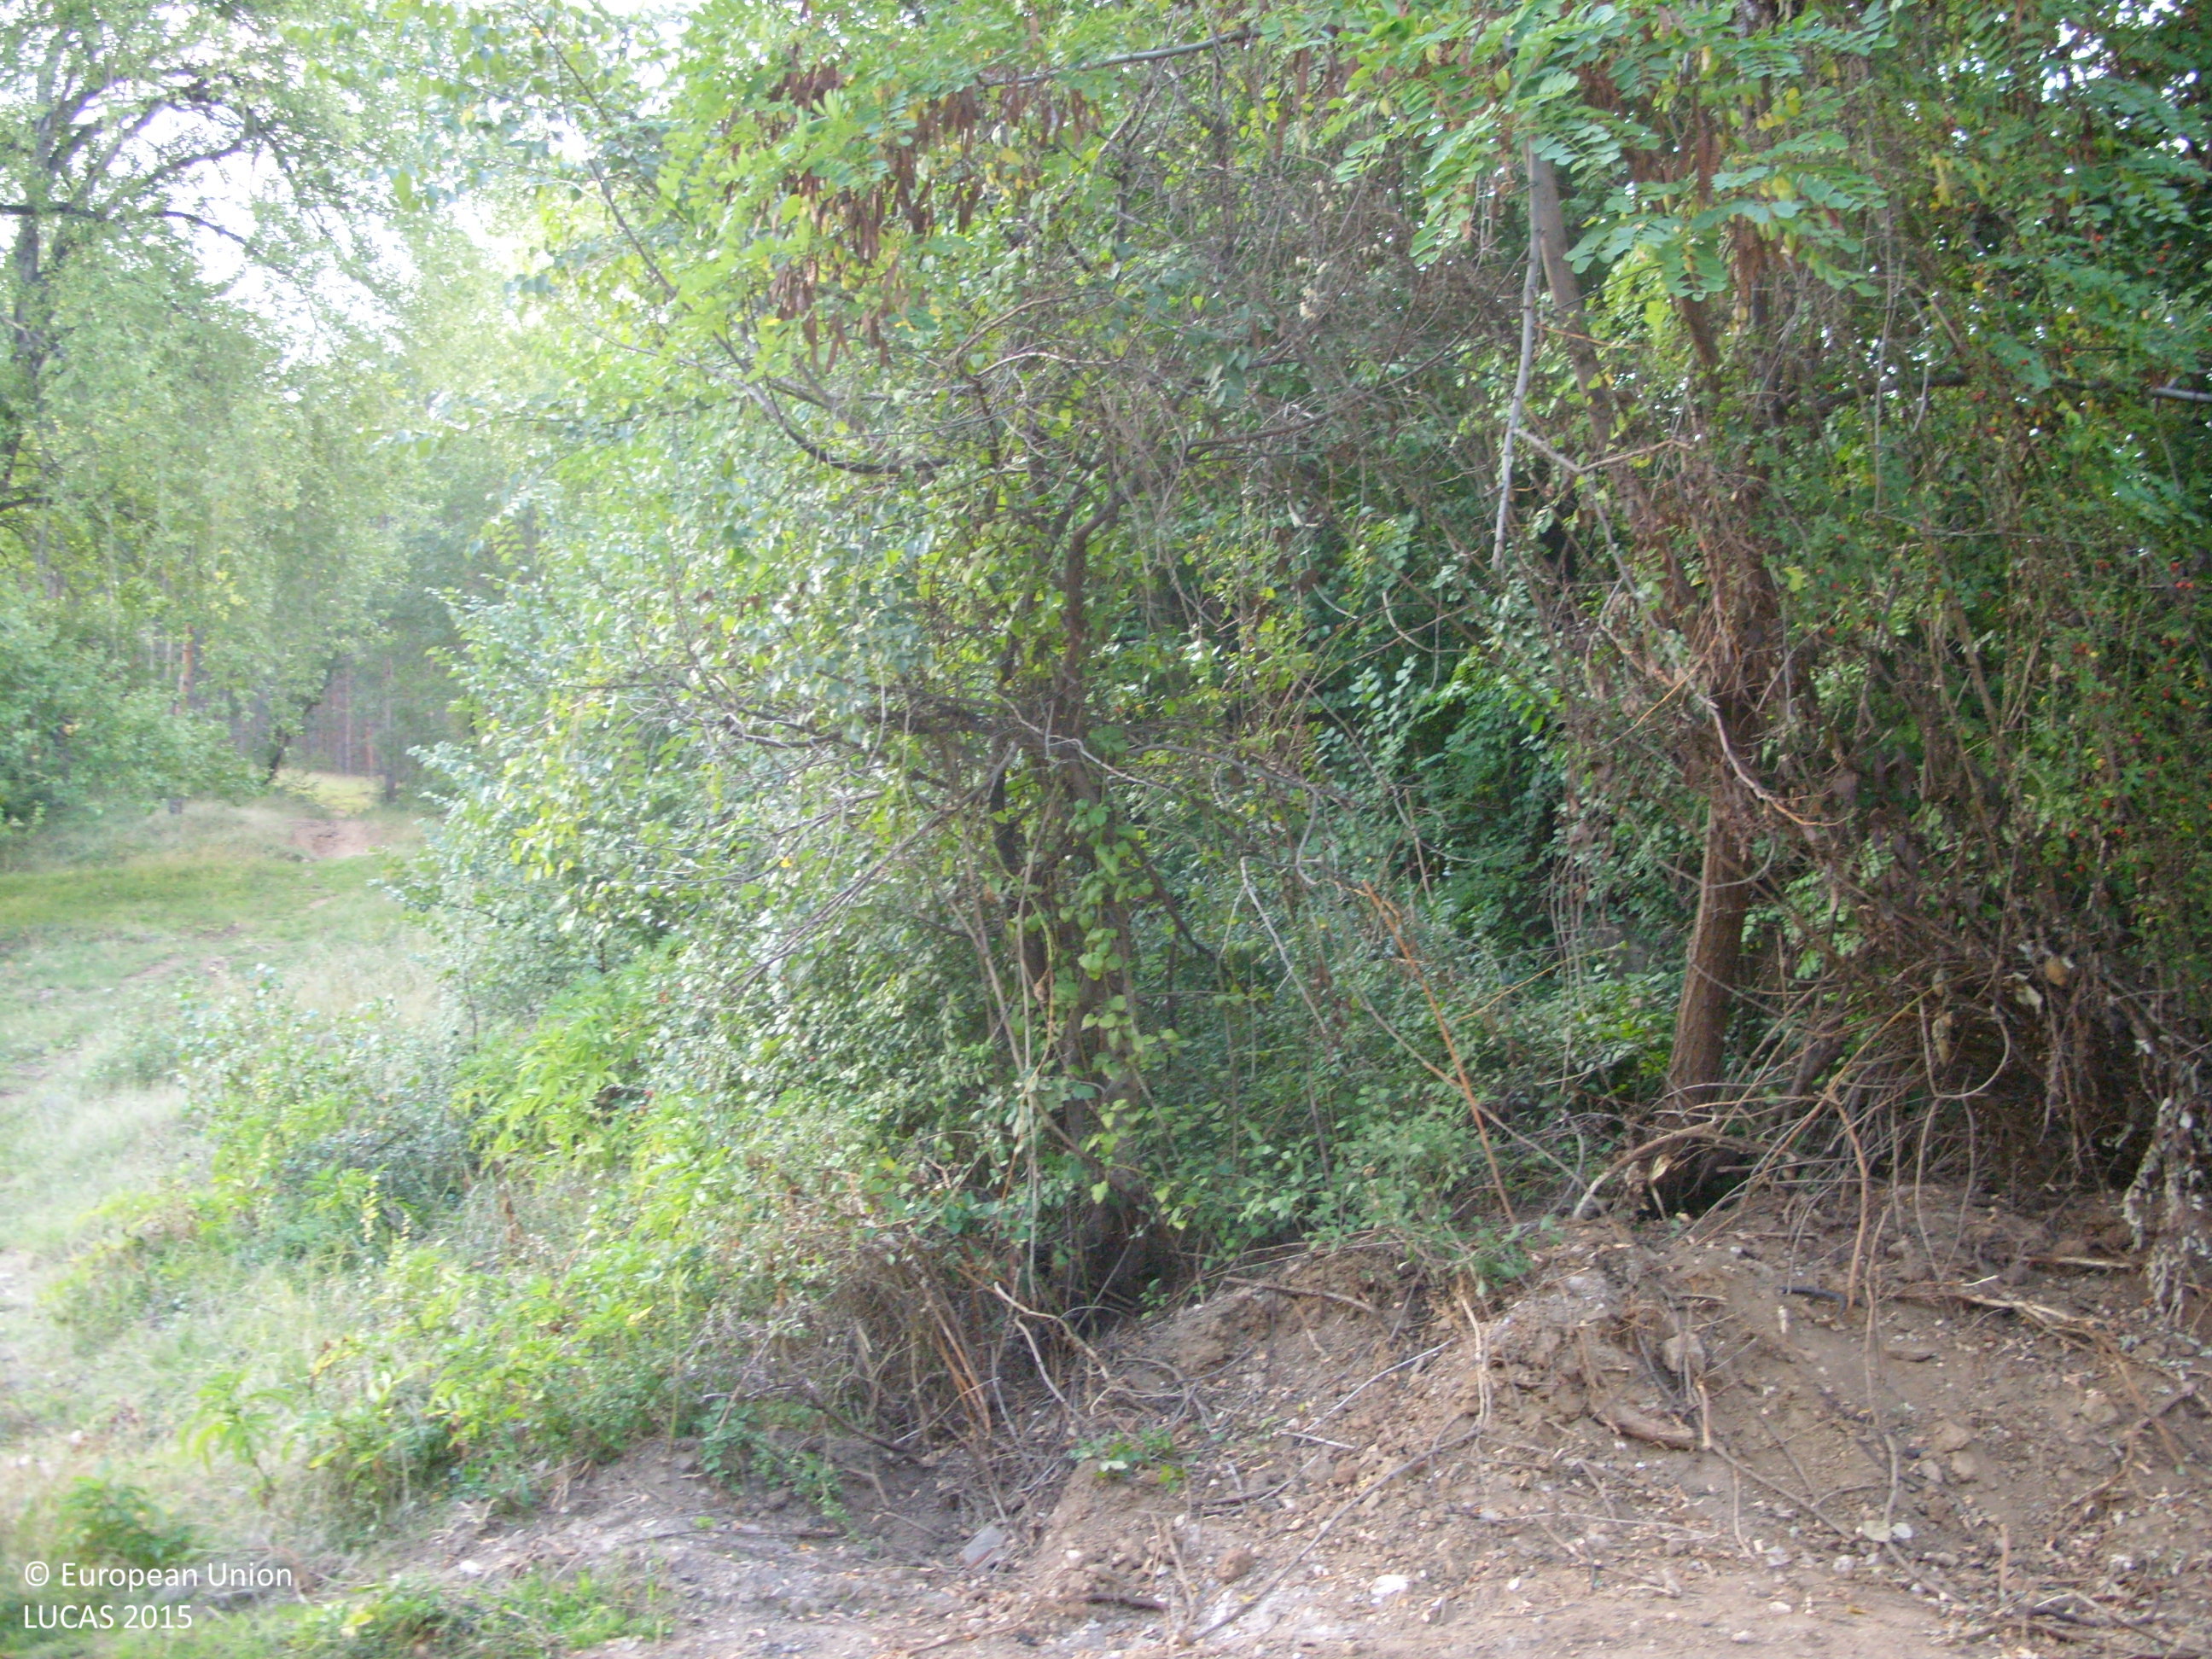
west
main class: Cropland
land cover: Other fruit trees and berries
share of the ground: 25 - 50 %
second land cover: Grassland without tree/shrub cover
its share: > 75 %
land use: Kitchen garden
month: October
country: BG
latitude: 42.1752
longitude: 24.0958
